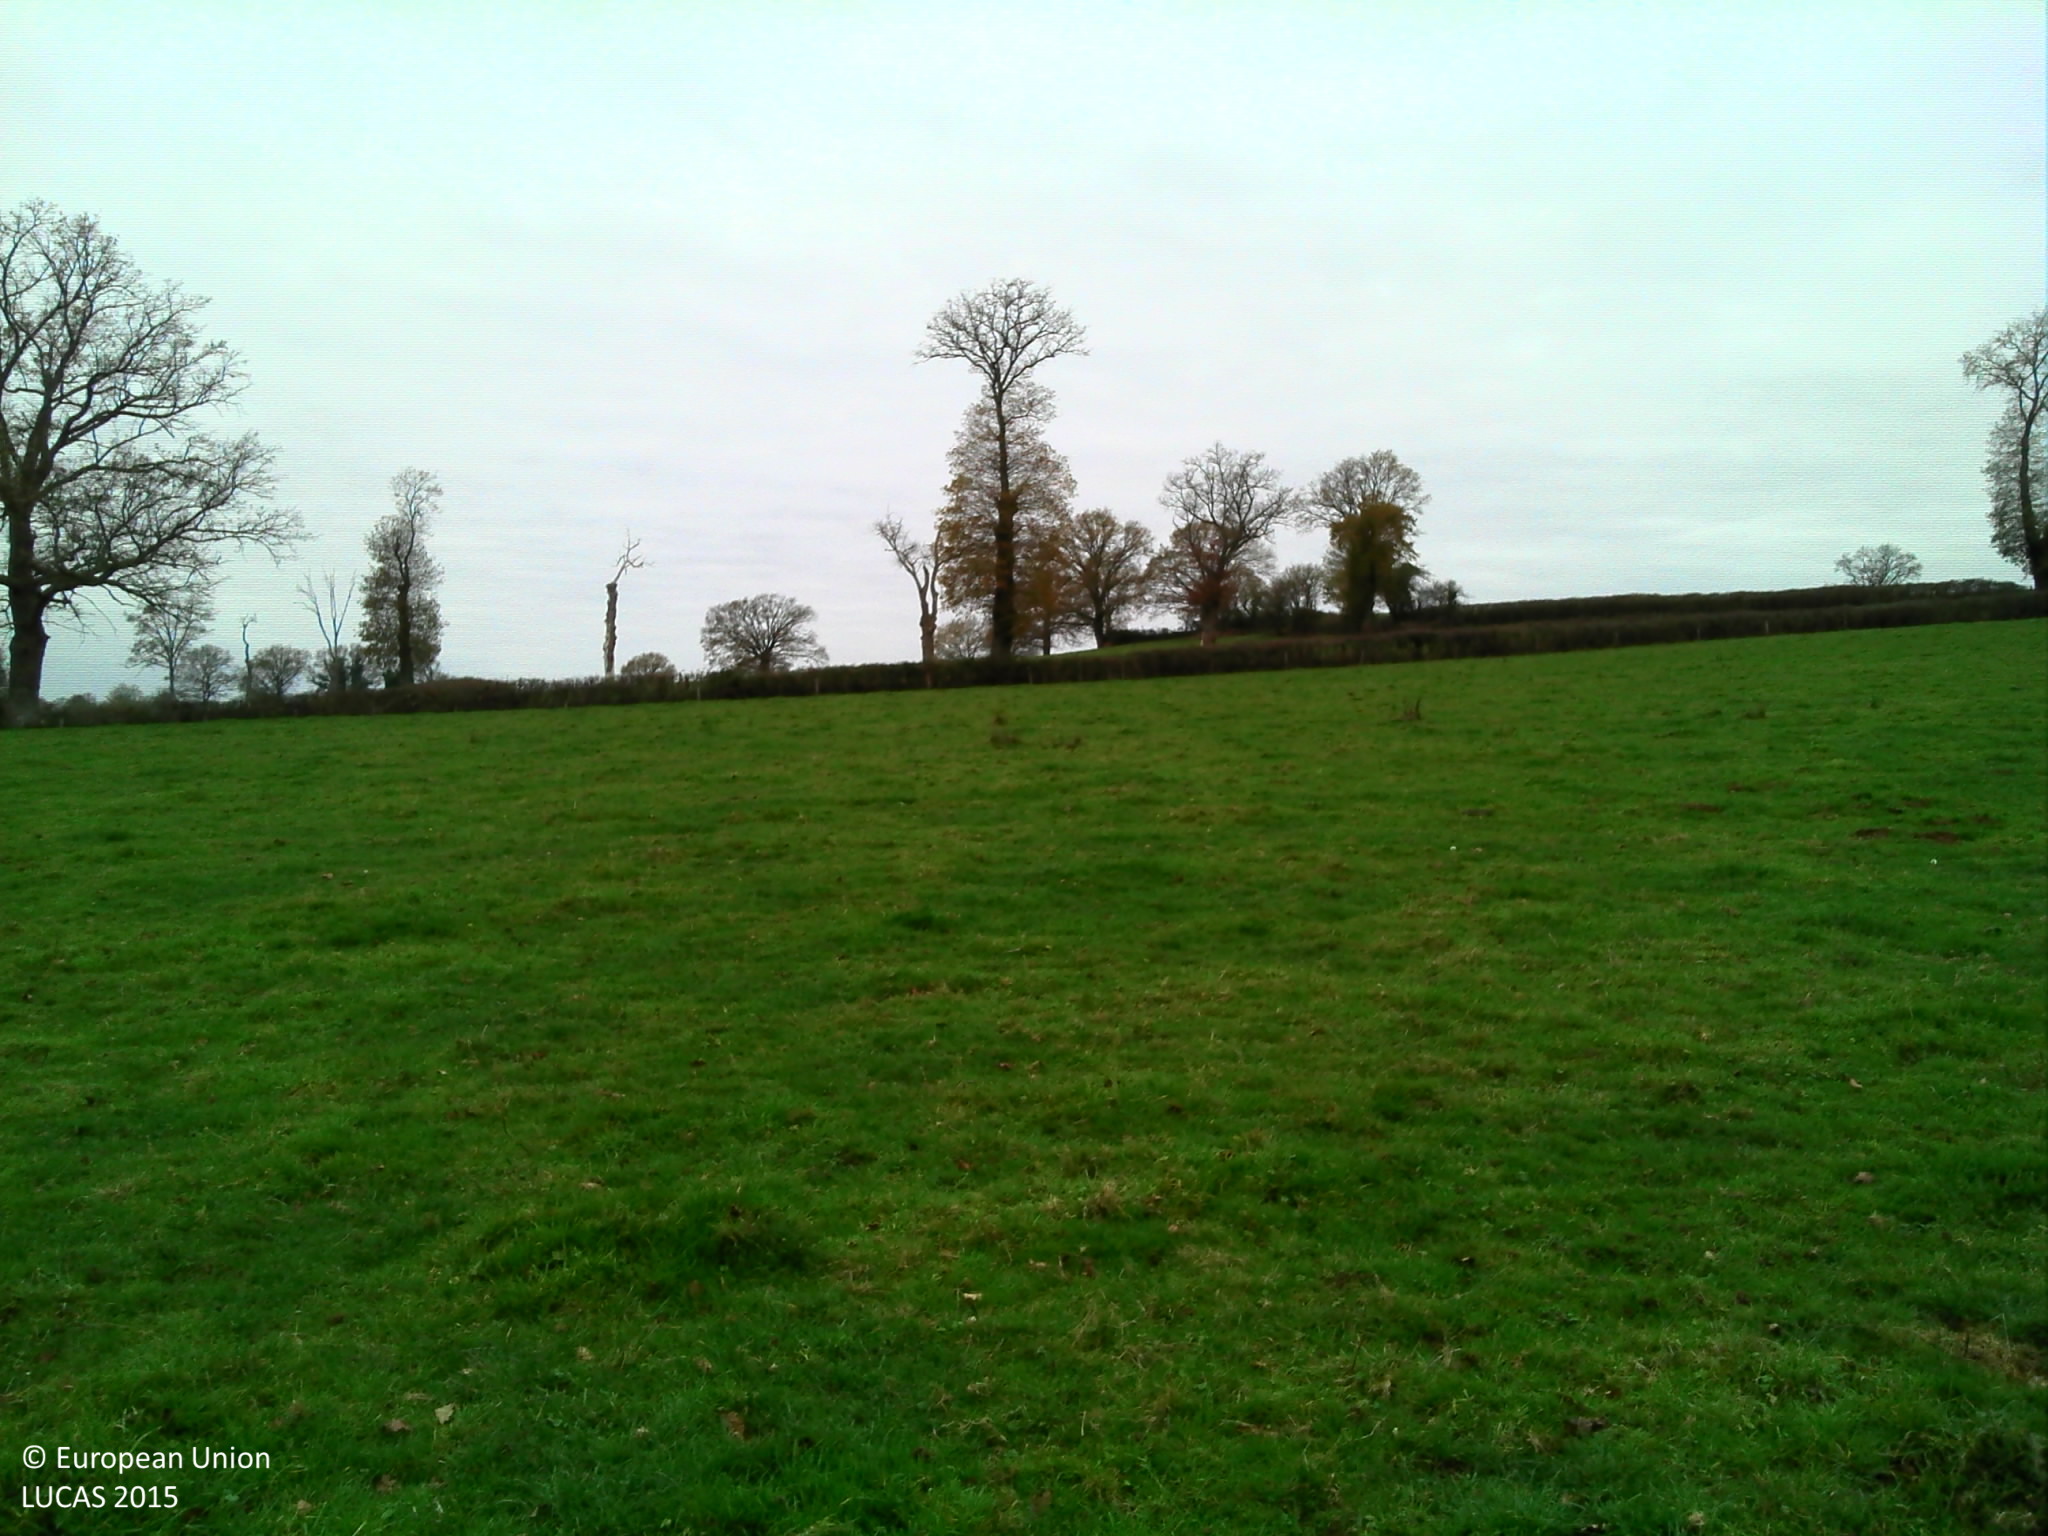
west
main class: Grassland
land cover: Grassland without tree/shrub cover
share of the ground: > 75 %
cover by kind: herbaceous plants 100 %
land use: Agriculture (excluding fallow land and kitchen gardens)
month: July
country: FR
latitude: 46.5355
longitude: 2.9690
